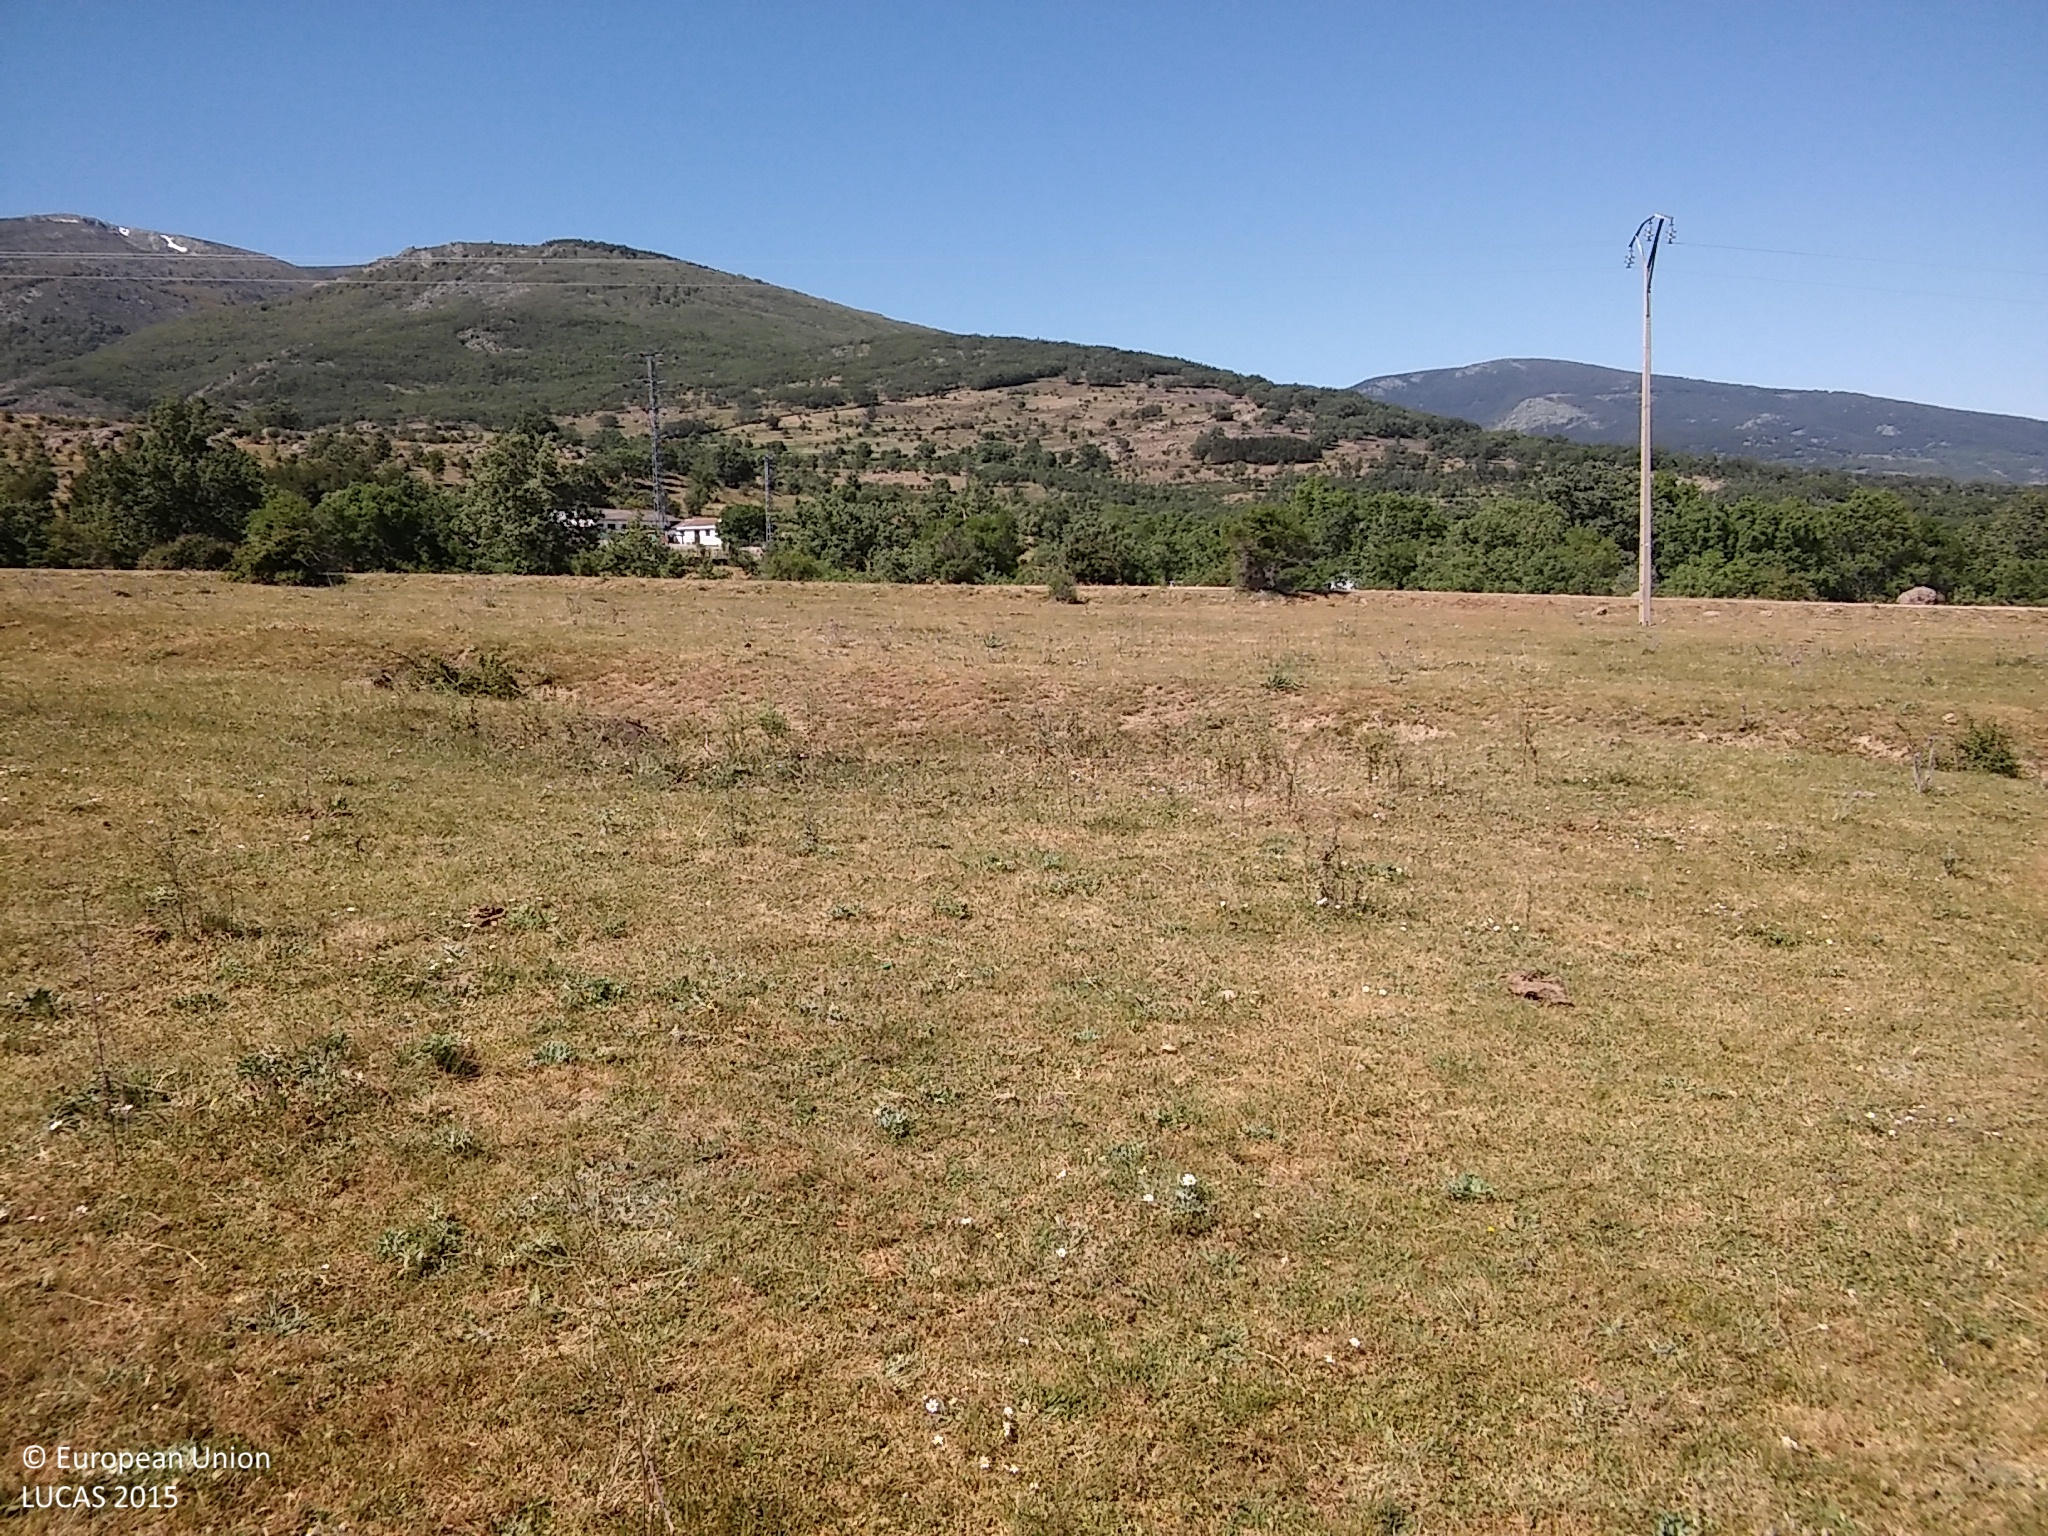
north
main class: Grassland
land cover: Grassland without tree/shrub cover
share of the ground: > 75 %
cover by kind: herbaceous plants 100 %
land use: Agriculture (excluding fallow land and kitchen gardens)
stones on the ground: < 10 %
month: May
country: ES
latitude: 40.9308
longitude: -3.8340
